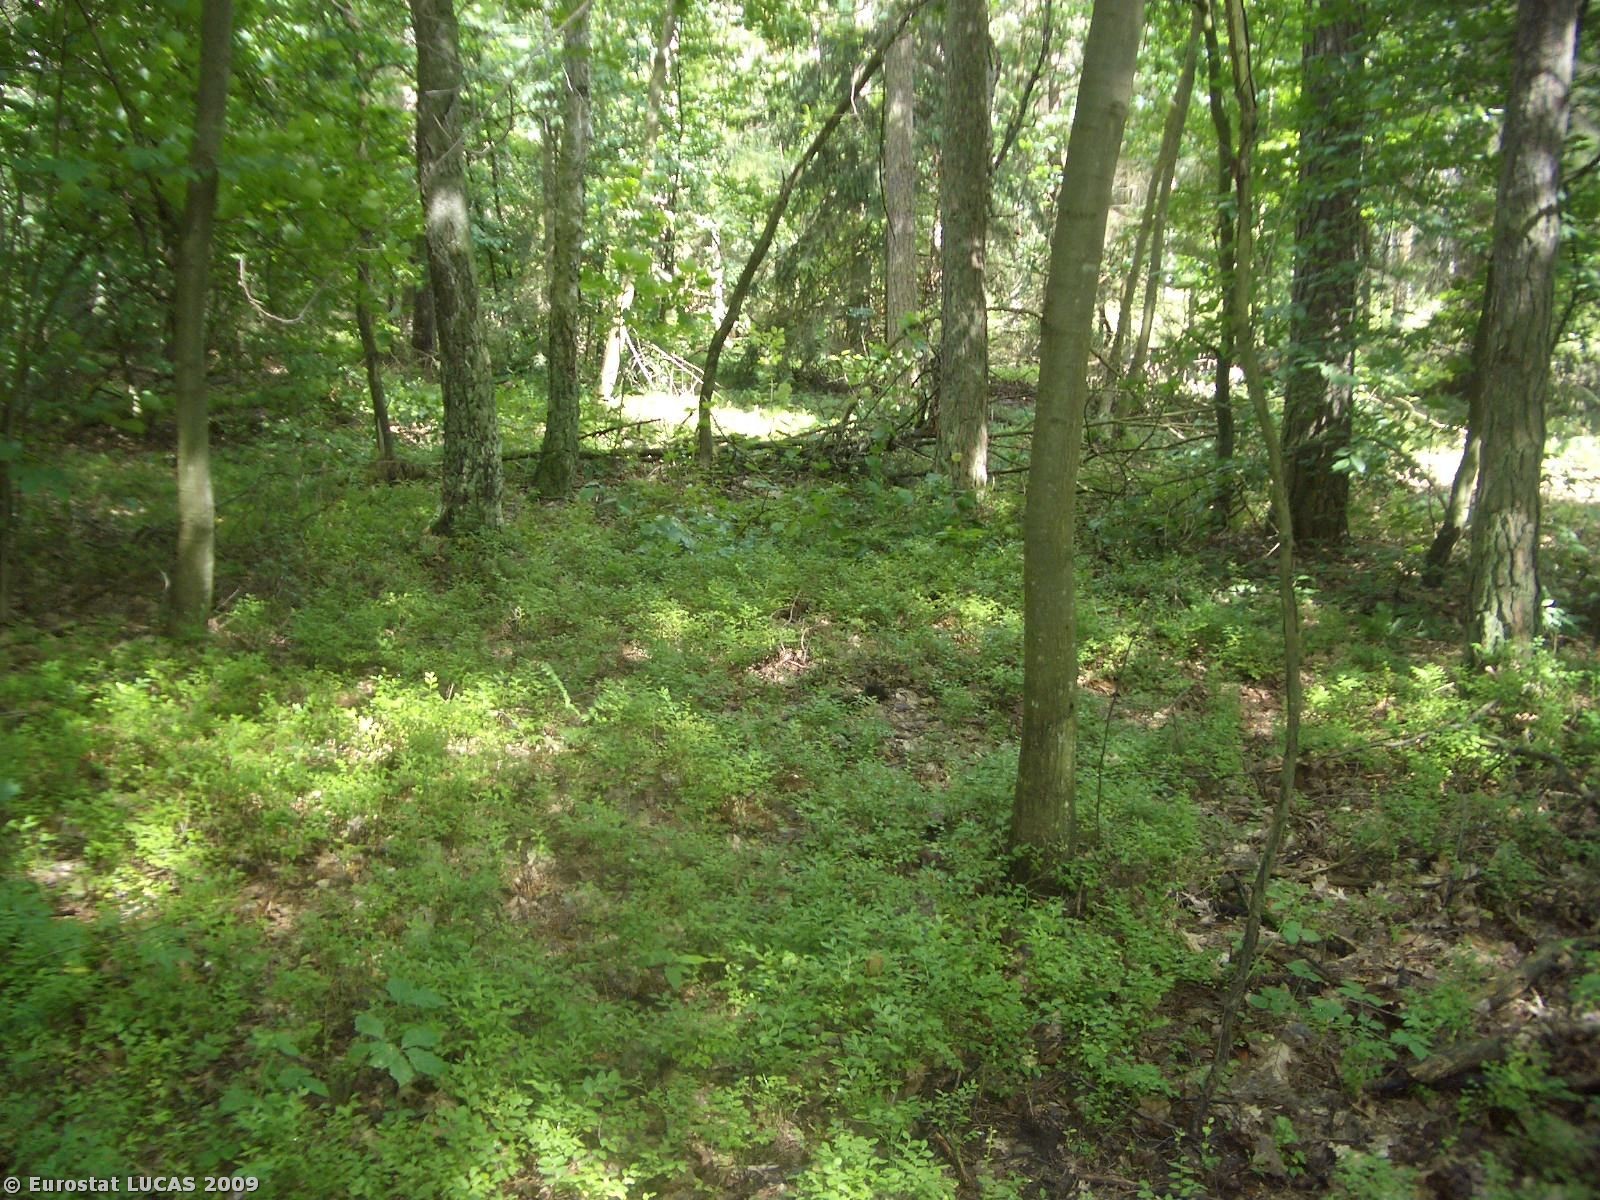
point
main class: Woodland
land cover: Mixed woodland
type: hemiboreal forest and nemoral coniferous forest and mixed broadleaved-coniferous forest
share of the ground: 50 - 75 %
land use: Forestry
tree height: > 5 m
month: July
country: PL
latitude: 51.7843
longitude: 22.5189
